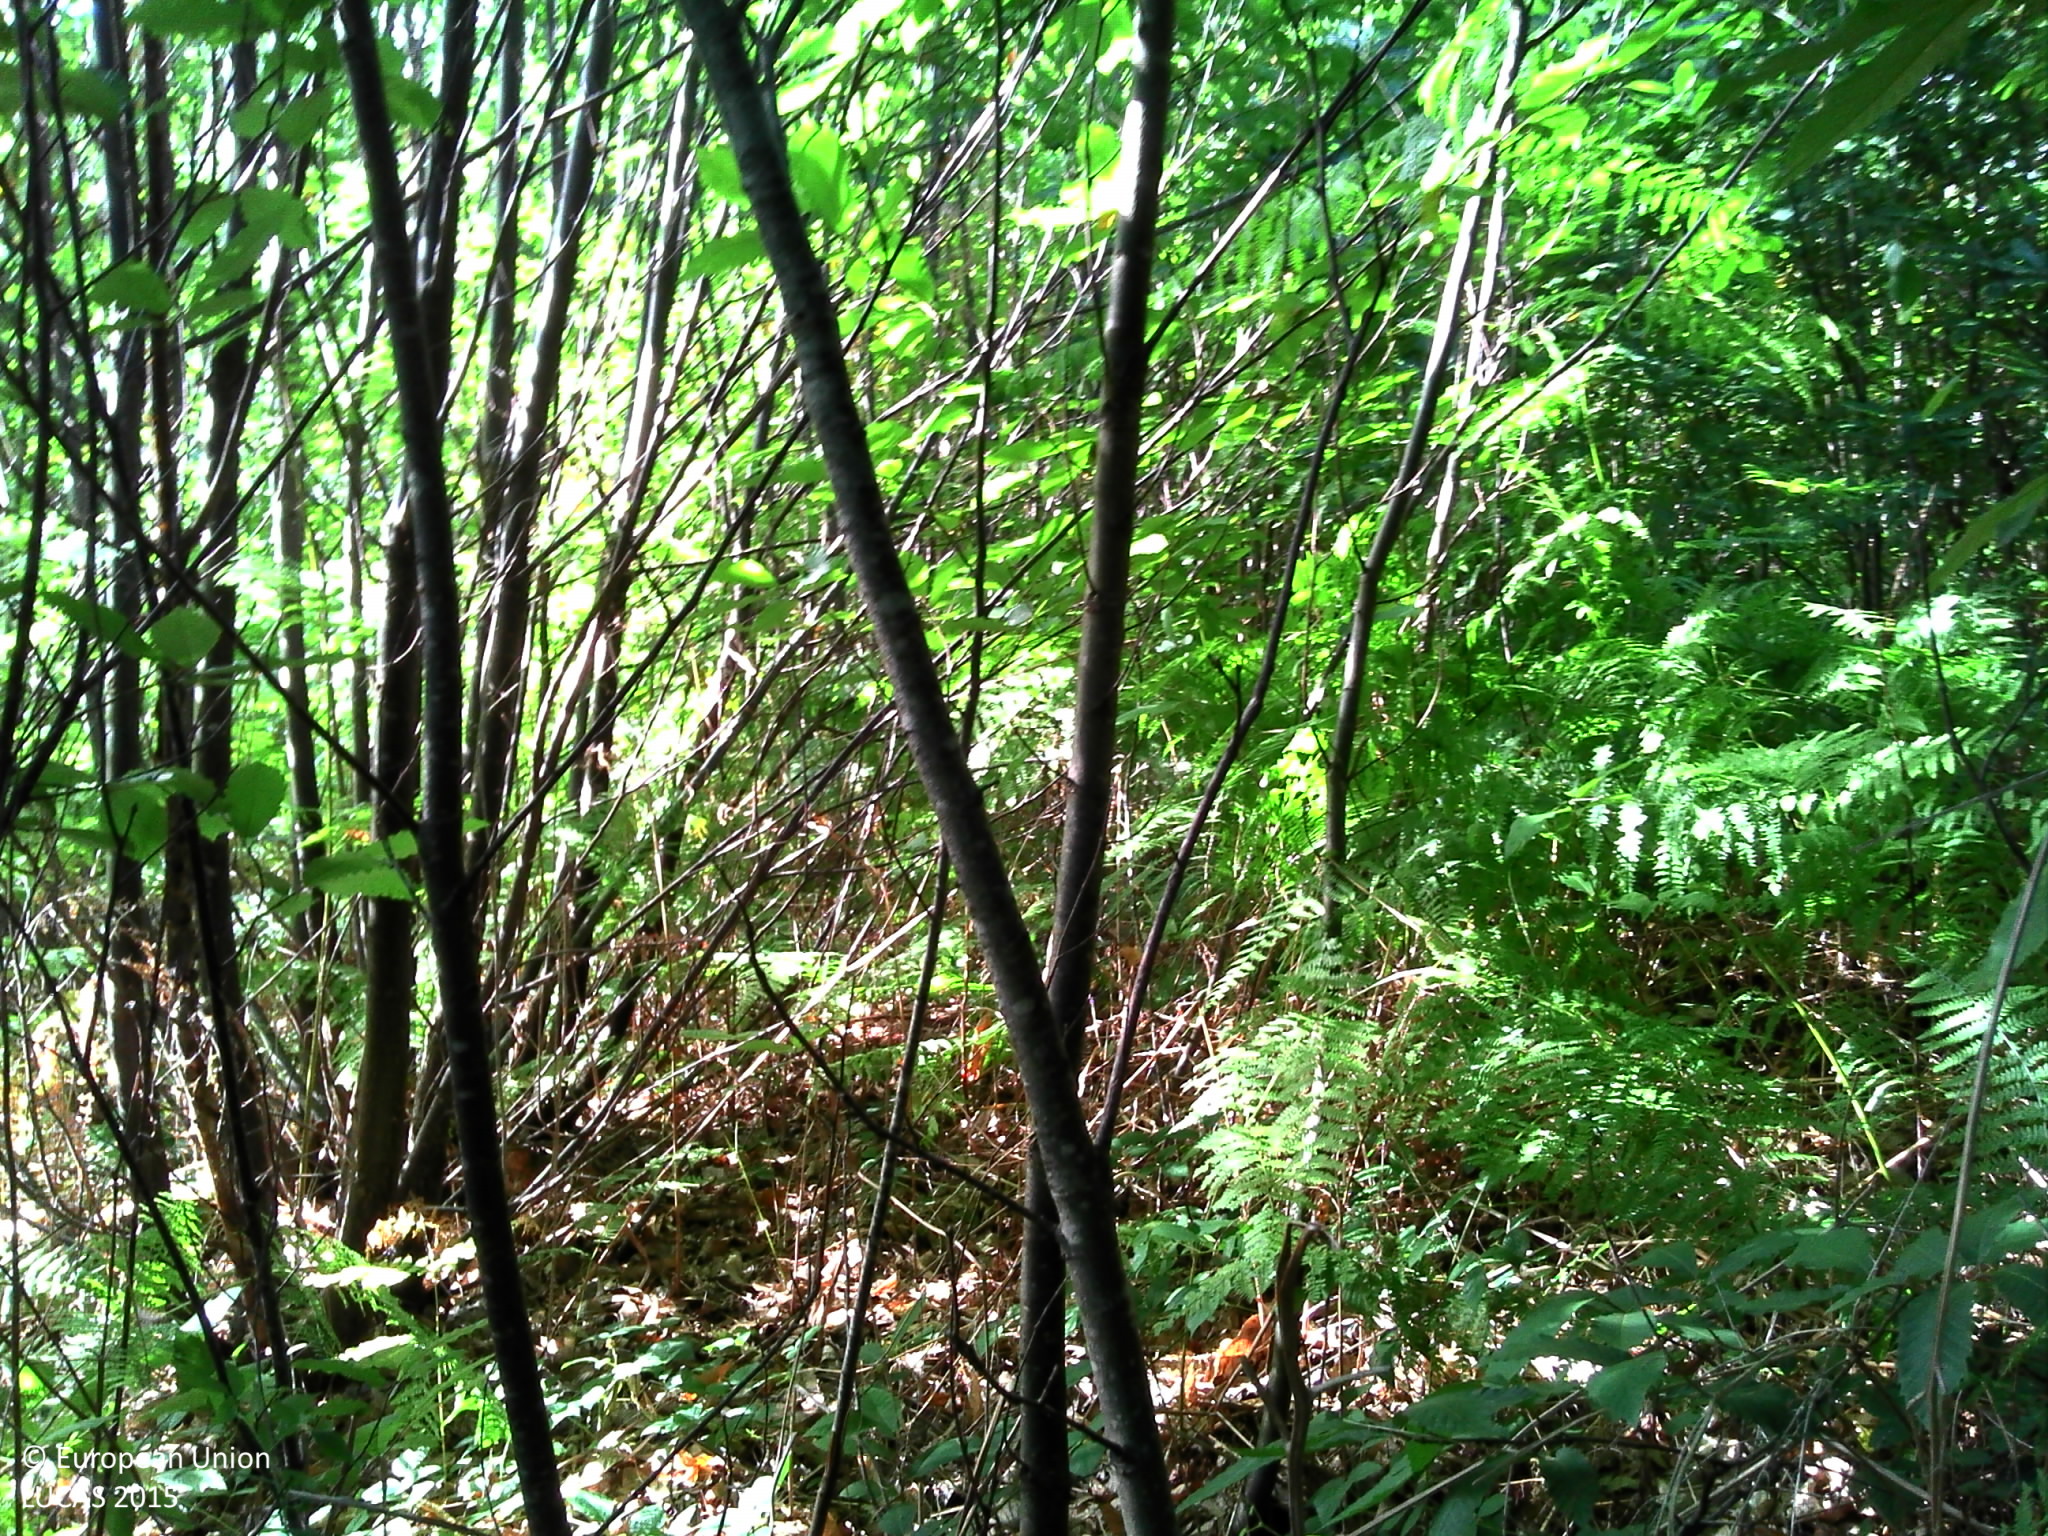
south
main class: Woodland
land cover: Broadleaved woodland
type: thermophilous deciduous forest
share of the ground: > 75 %
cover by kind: broadleaved forest trees 80 %, herbaceous plants 10 %, shrubs 5 %, lichens and mosses 5 %
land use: Forestry
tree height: > 5 m
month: July
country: FR
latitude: 45.0129
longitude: 0.8177
